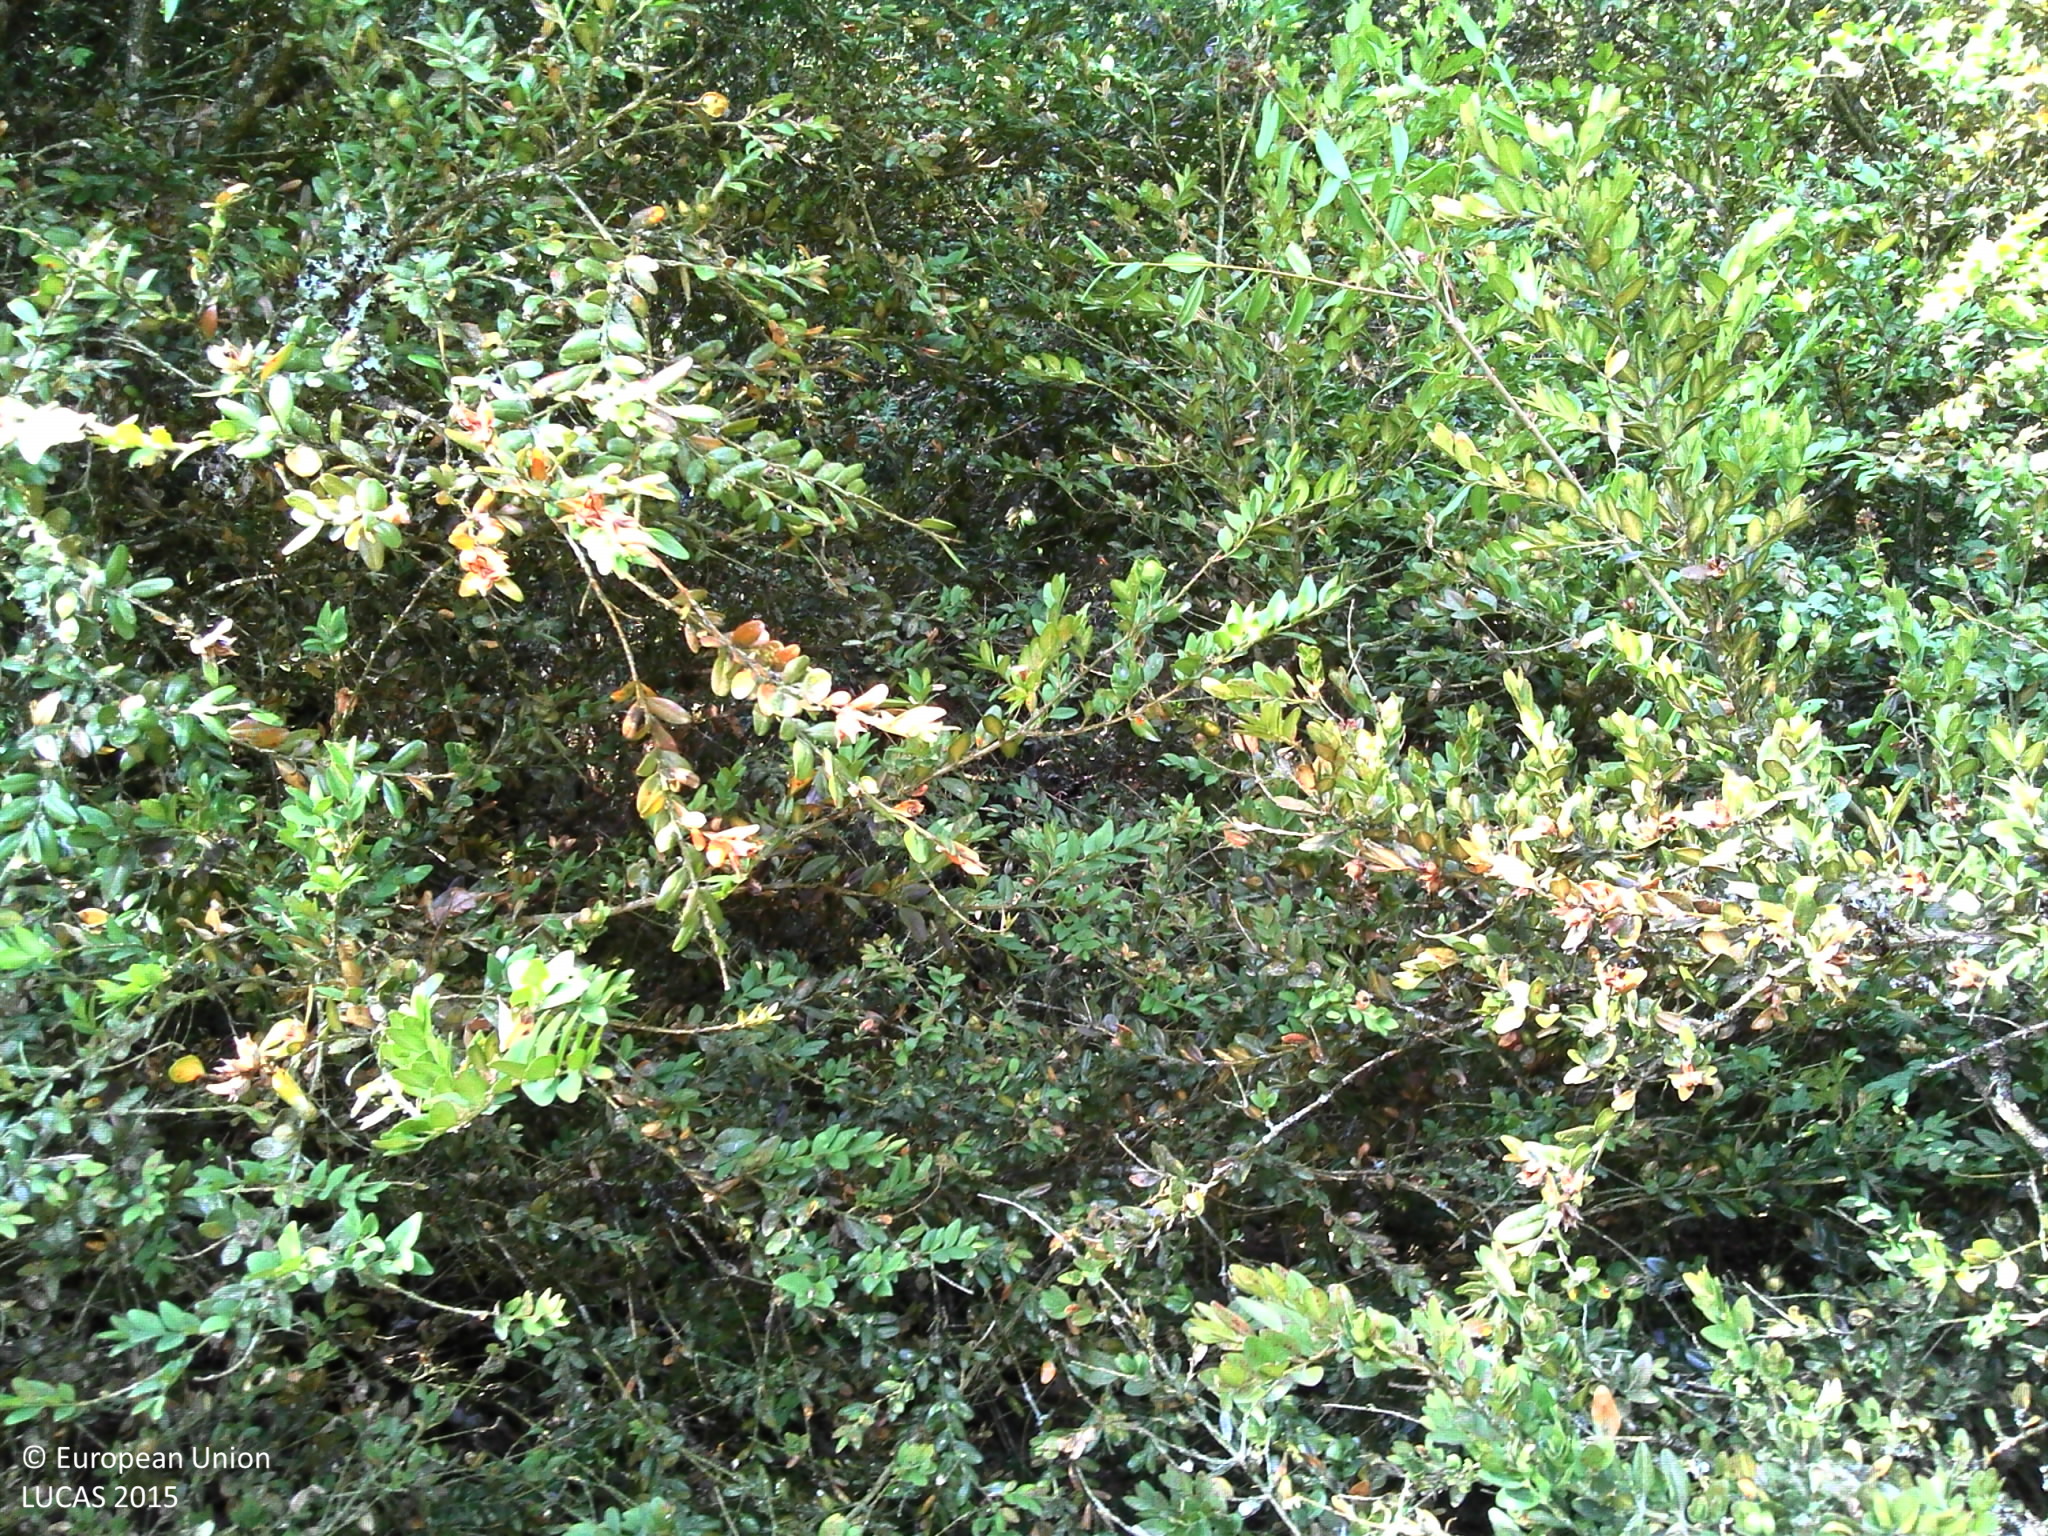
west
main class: Woodland
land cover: Broadleaved woodland
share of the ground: > 75 %
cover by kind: broadleaved forest trees 70 %, herbaceous plants 15 %, shrubs 10 %, lichens and mosses 5 %
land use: Forestry
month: August
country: FR
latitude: 43.8871
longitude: 3.1235
